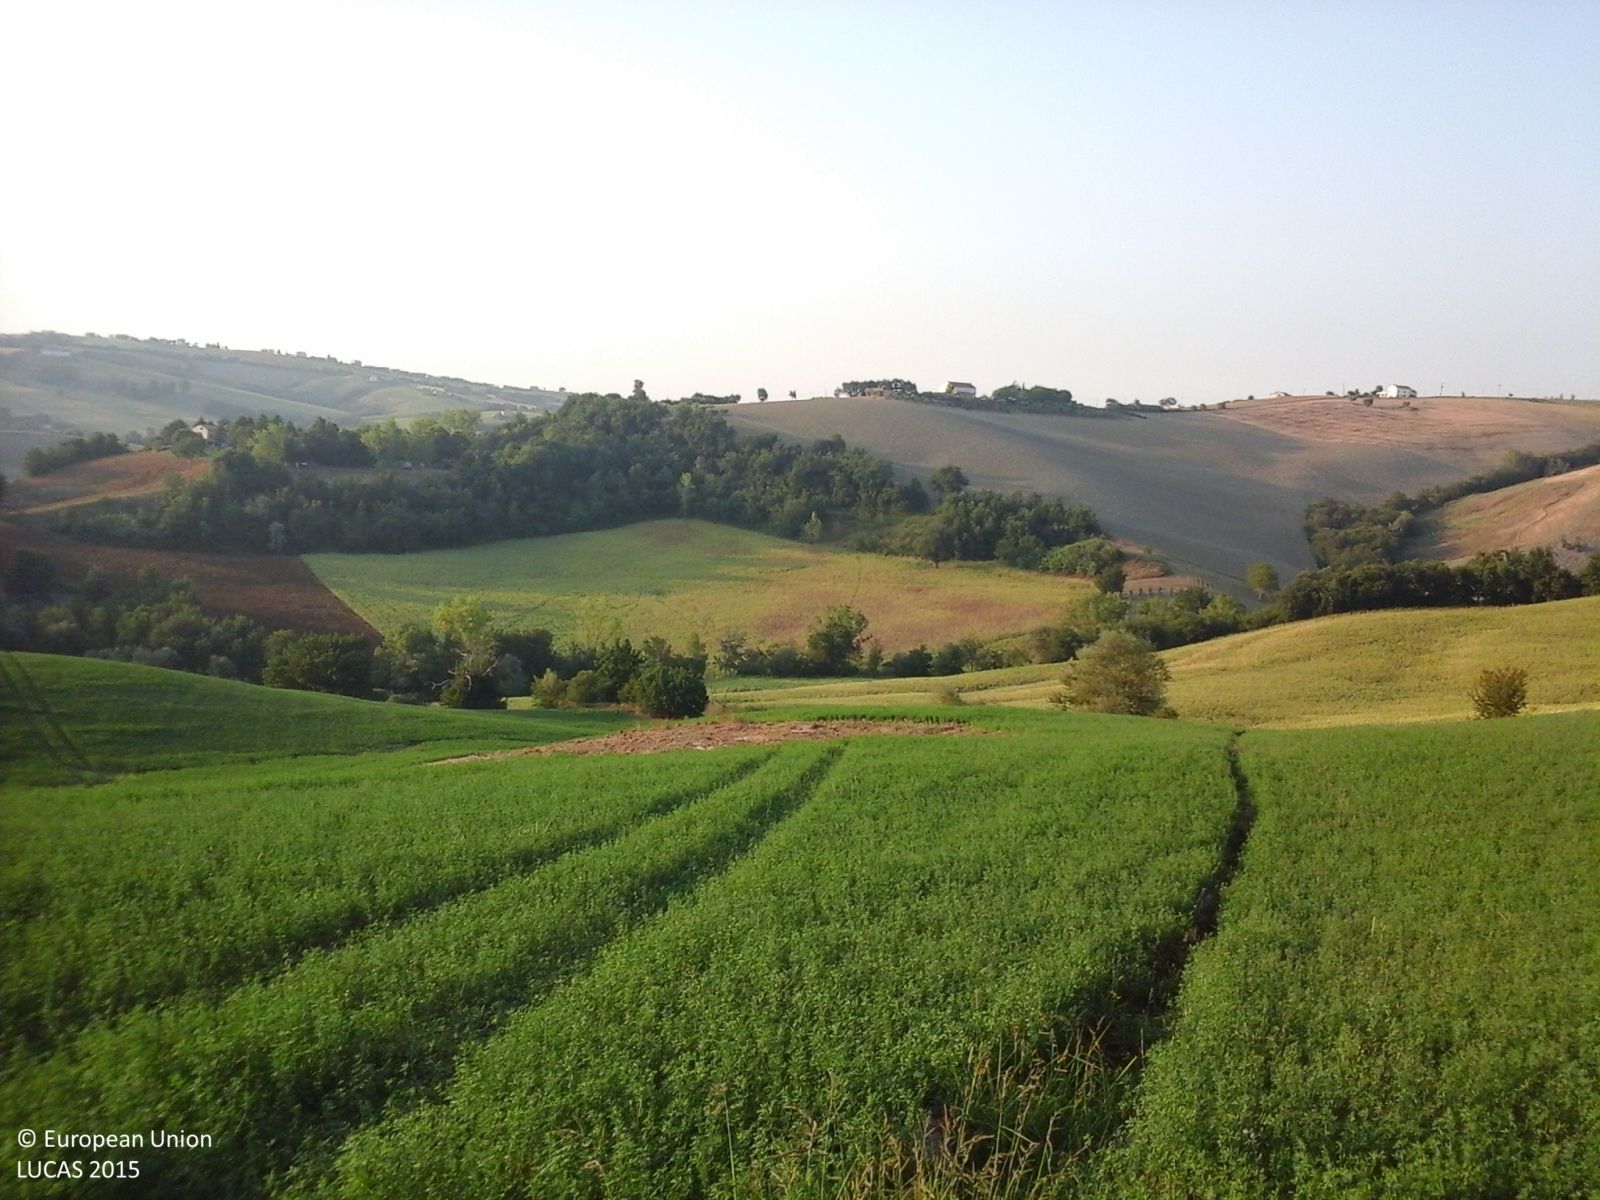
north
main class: Cropland
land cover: Lucerne
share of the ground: > 75 %
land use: Agriculture (excluding fallow land and kitchen gardens)
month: August
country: IT
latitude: 43.1376
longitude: 13.4455
